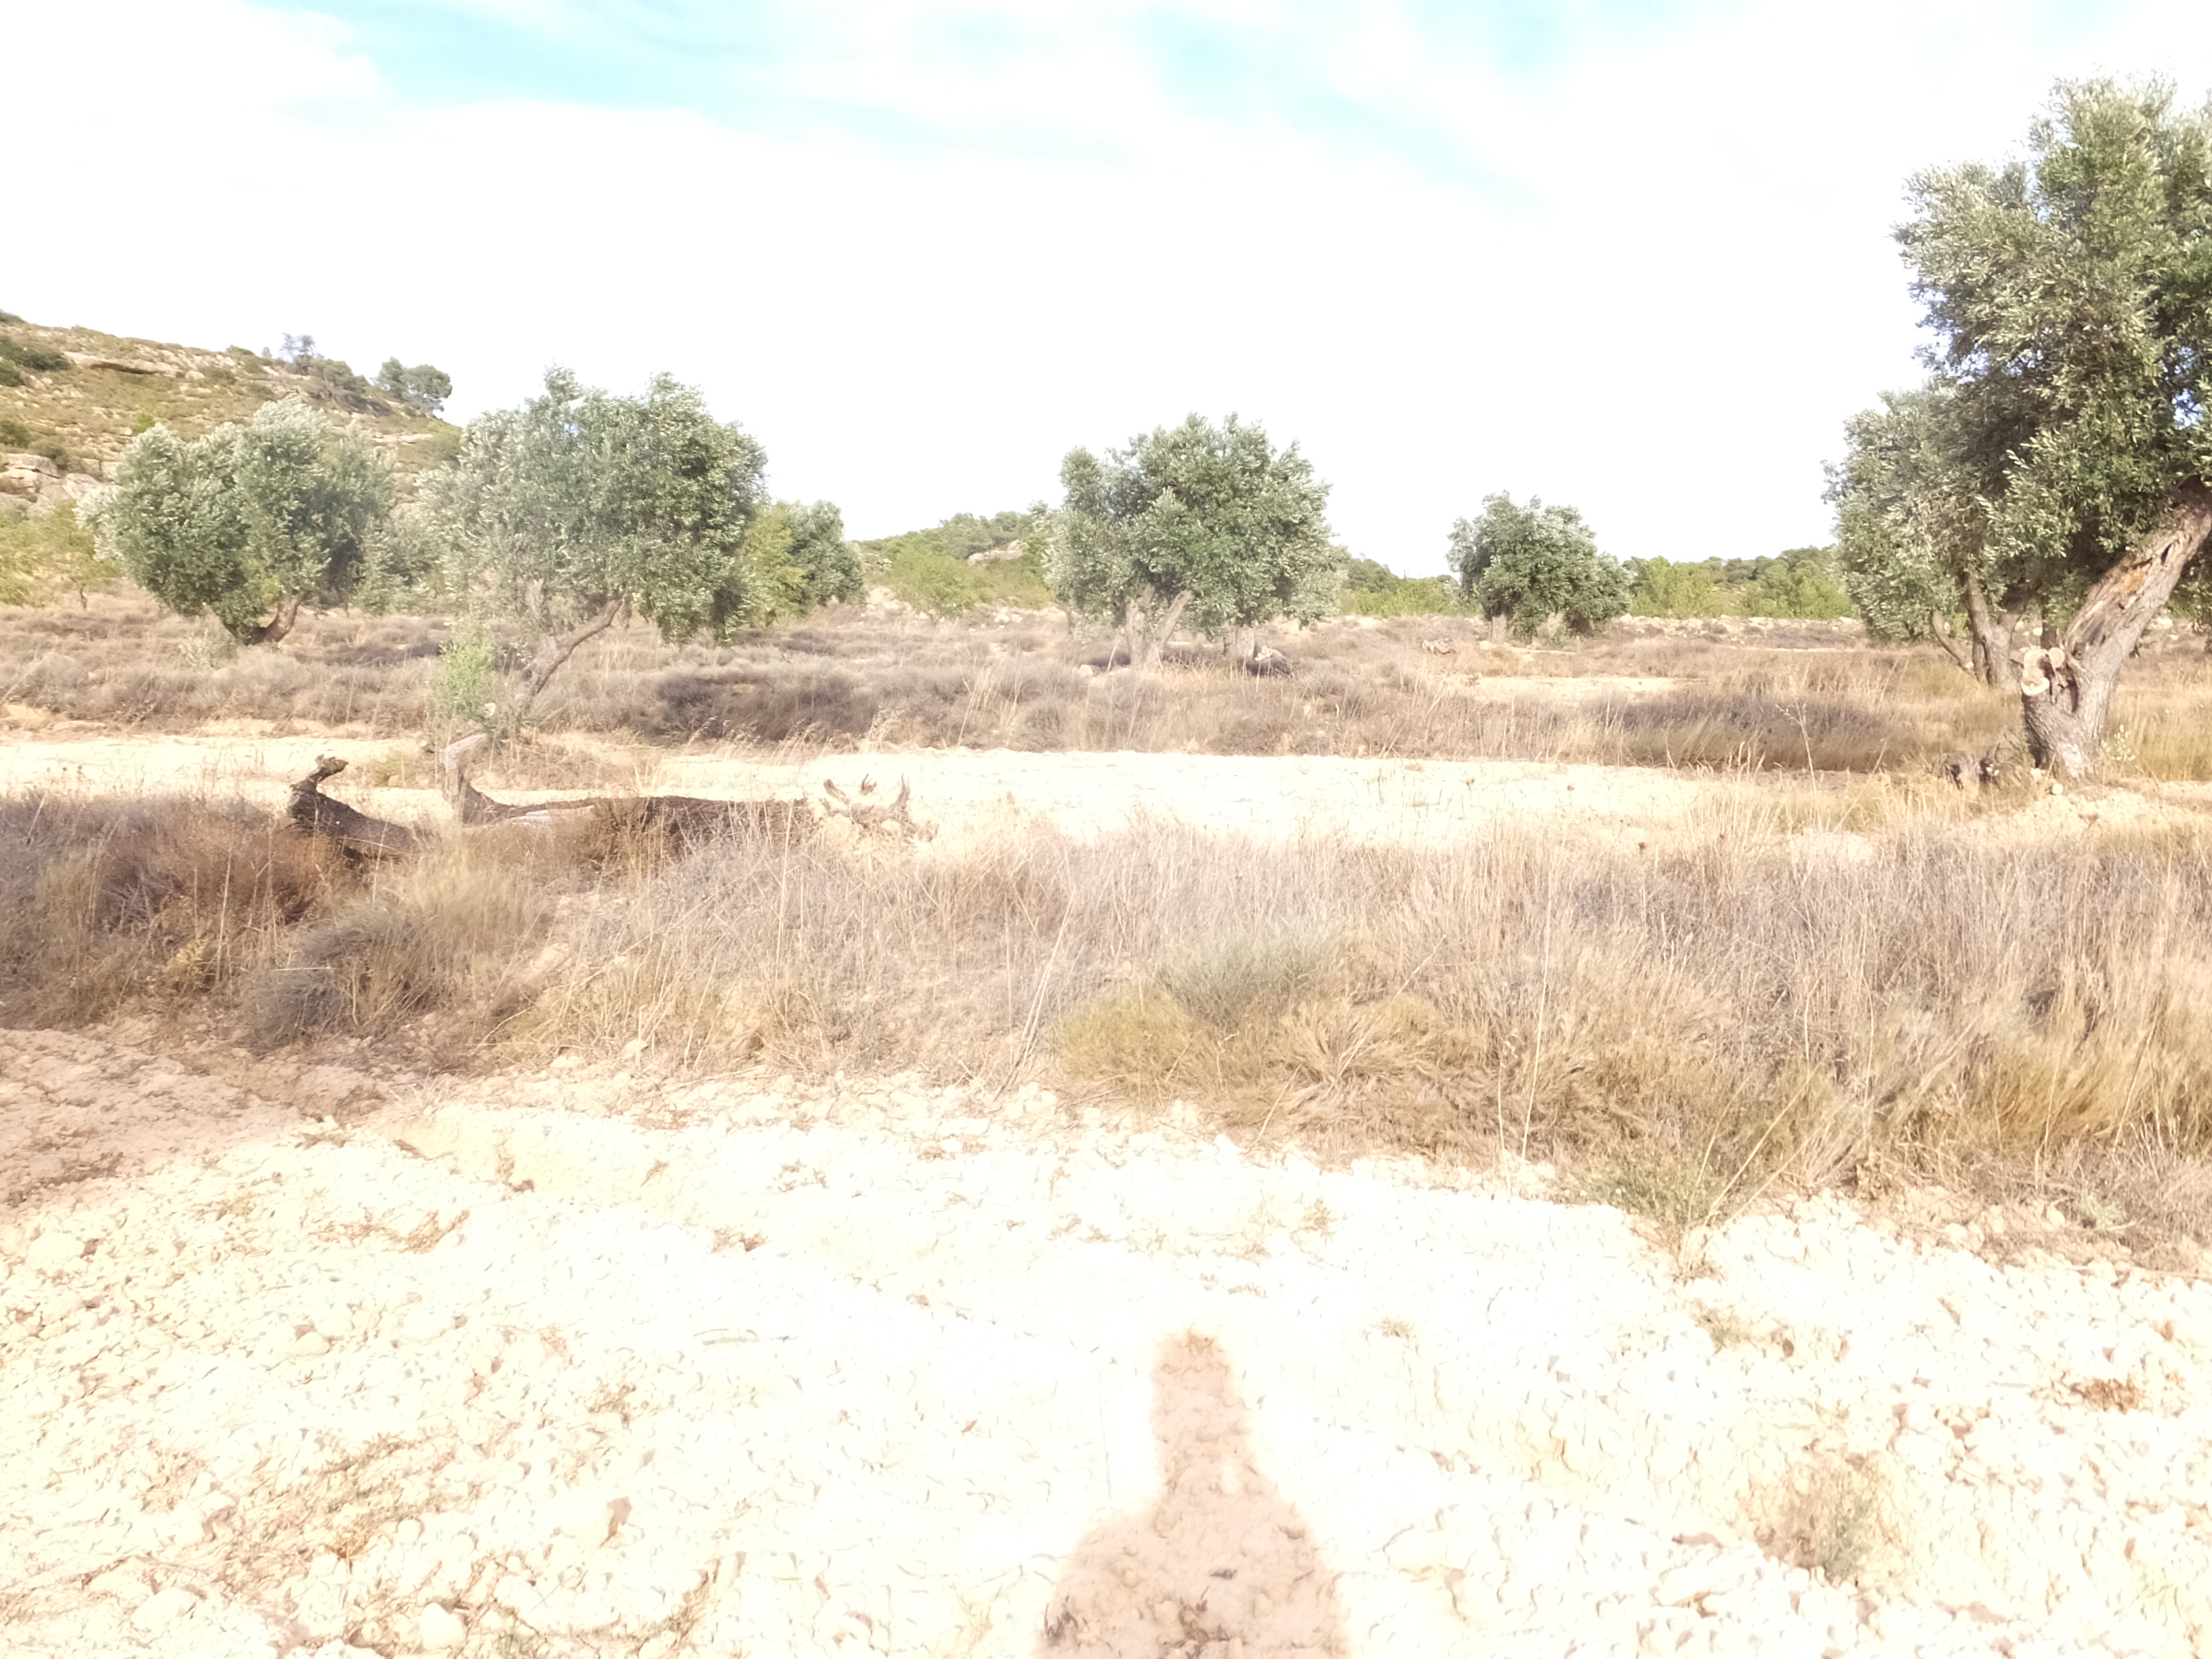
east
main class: Cropland
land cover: Olive groves
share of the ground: > 75 %
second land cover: Other bare soil
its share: > 75 %
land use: Agriculture (excluding fallow land and kitchen gardens)
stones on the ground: 10 - 25 %
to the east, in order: Olive groves; Other bare soil; Grassland with sparse tree/shrub cover; Shruby margins; Olive groves; Shruby margins; Olive groves; Shruby margins; Olive groves; Shruby margins; Olive groves; Shruby margins; Olive groves; Shruby margins; Tracks; Shruby margins; Nuts trees; Shruby margins; Nuts trees; Shruby margins; Nuts trees; Shruby margins; Nuts trees; Shruby margins
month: August
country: ES
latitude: 41.2446
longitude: 0.1439
